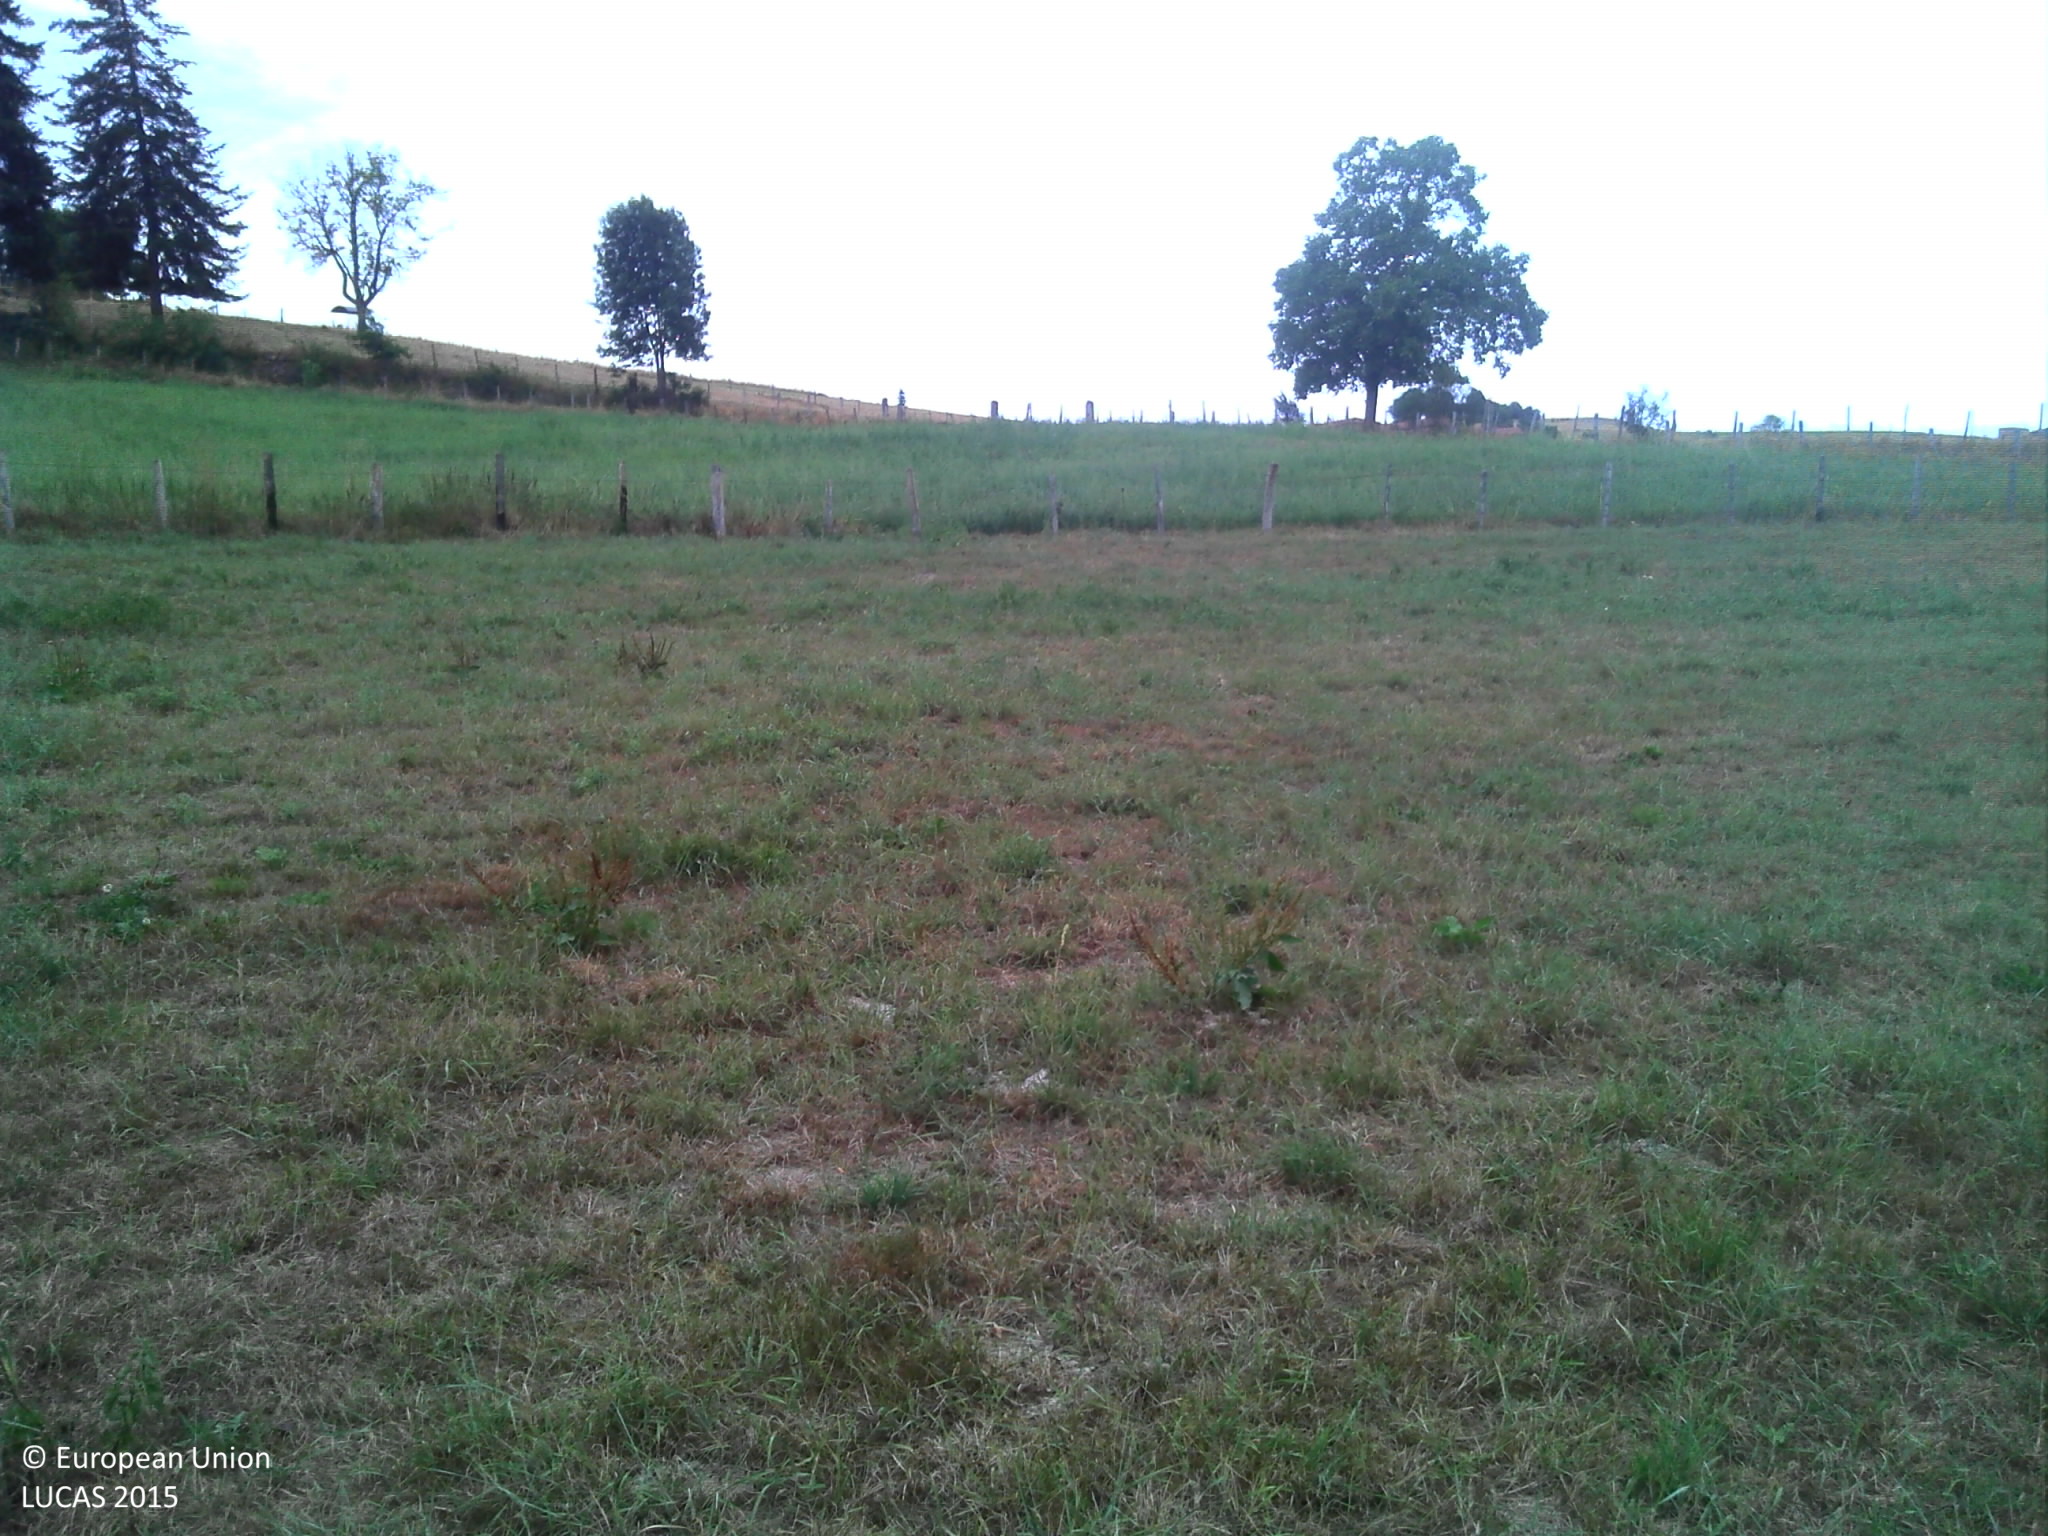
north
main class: Grassland
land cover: Grassland without tree/shrub cover
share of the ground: > 75 %
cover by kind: herbaceous plants 100 %
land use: Agriculture (excluding fallow land and kitchen gardens)
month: July
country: FR
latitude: 45.6486
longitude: 4.4730
